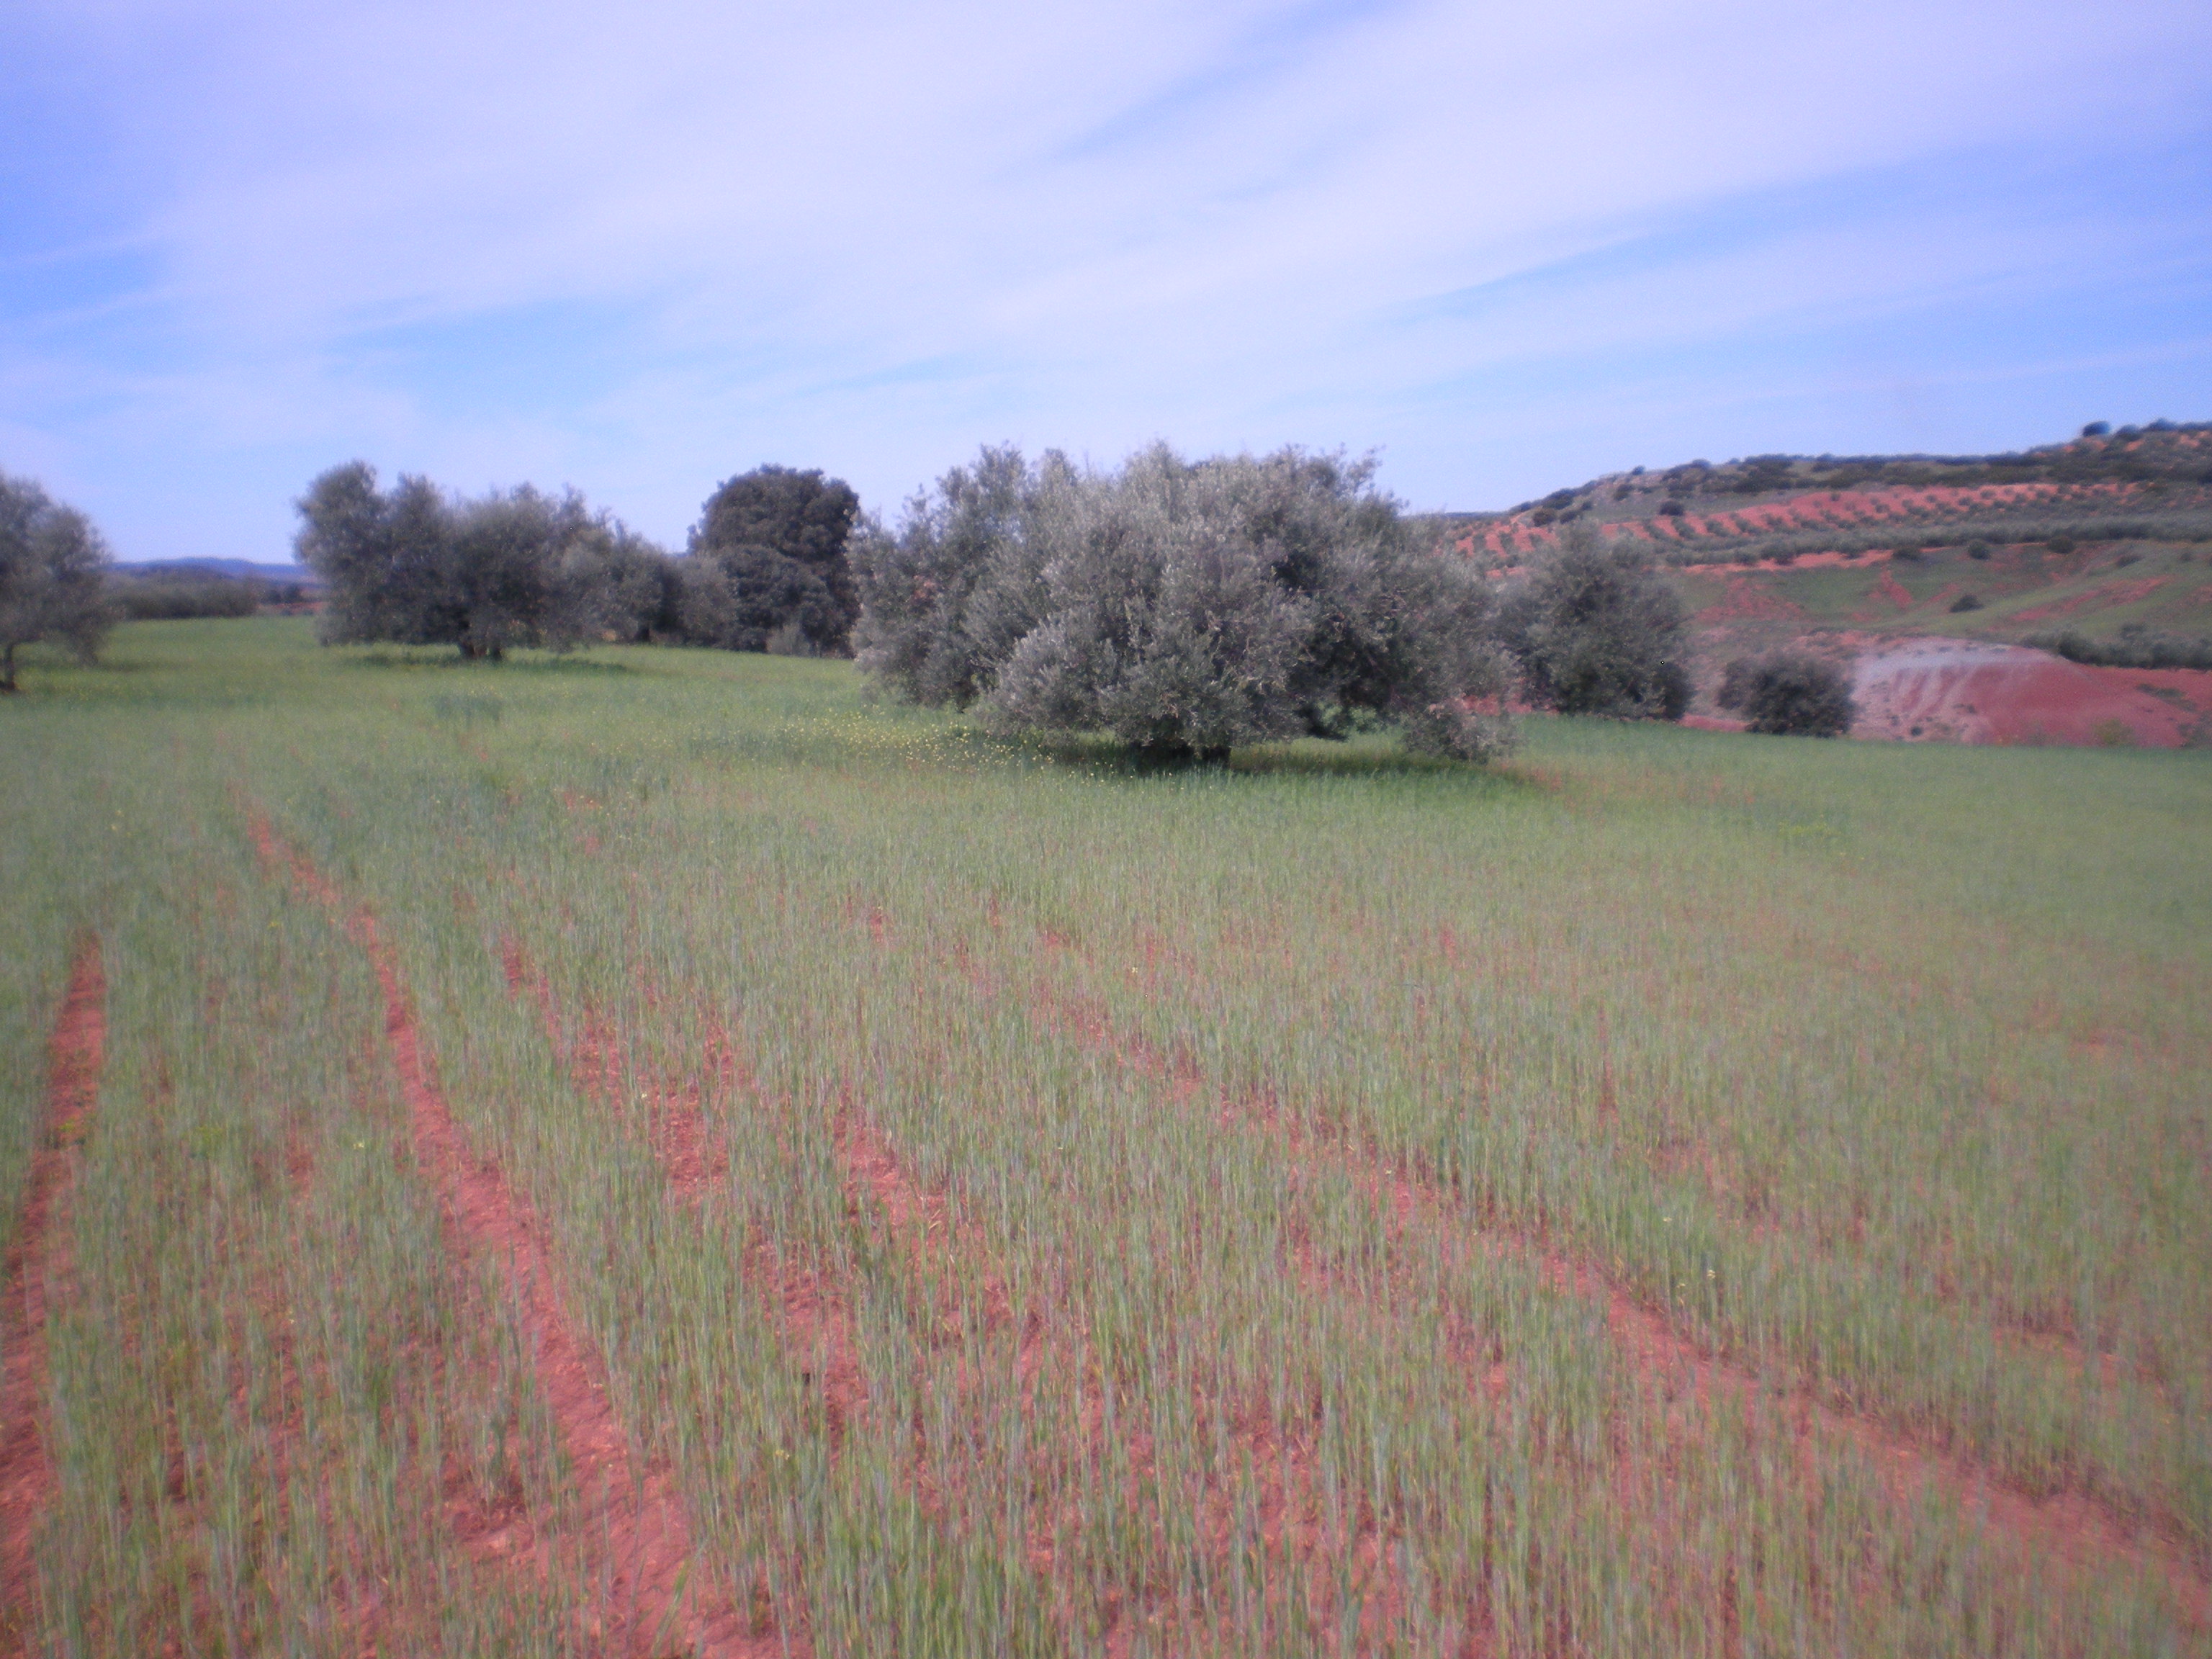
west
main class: Cropland
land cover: Durum wheat
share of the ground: 50 - 75 %
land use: Agriculture (excluding fallow land and kitchen gardens)
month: April
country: ES
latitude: 38.6150
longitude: -2.9710
